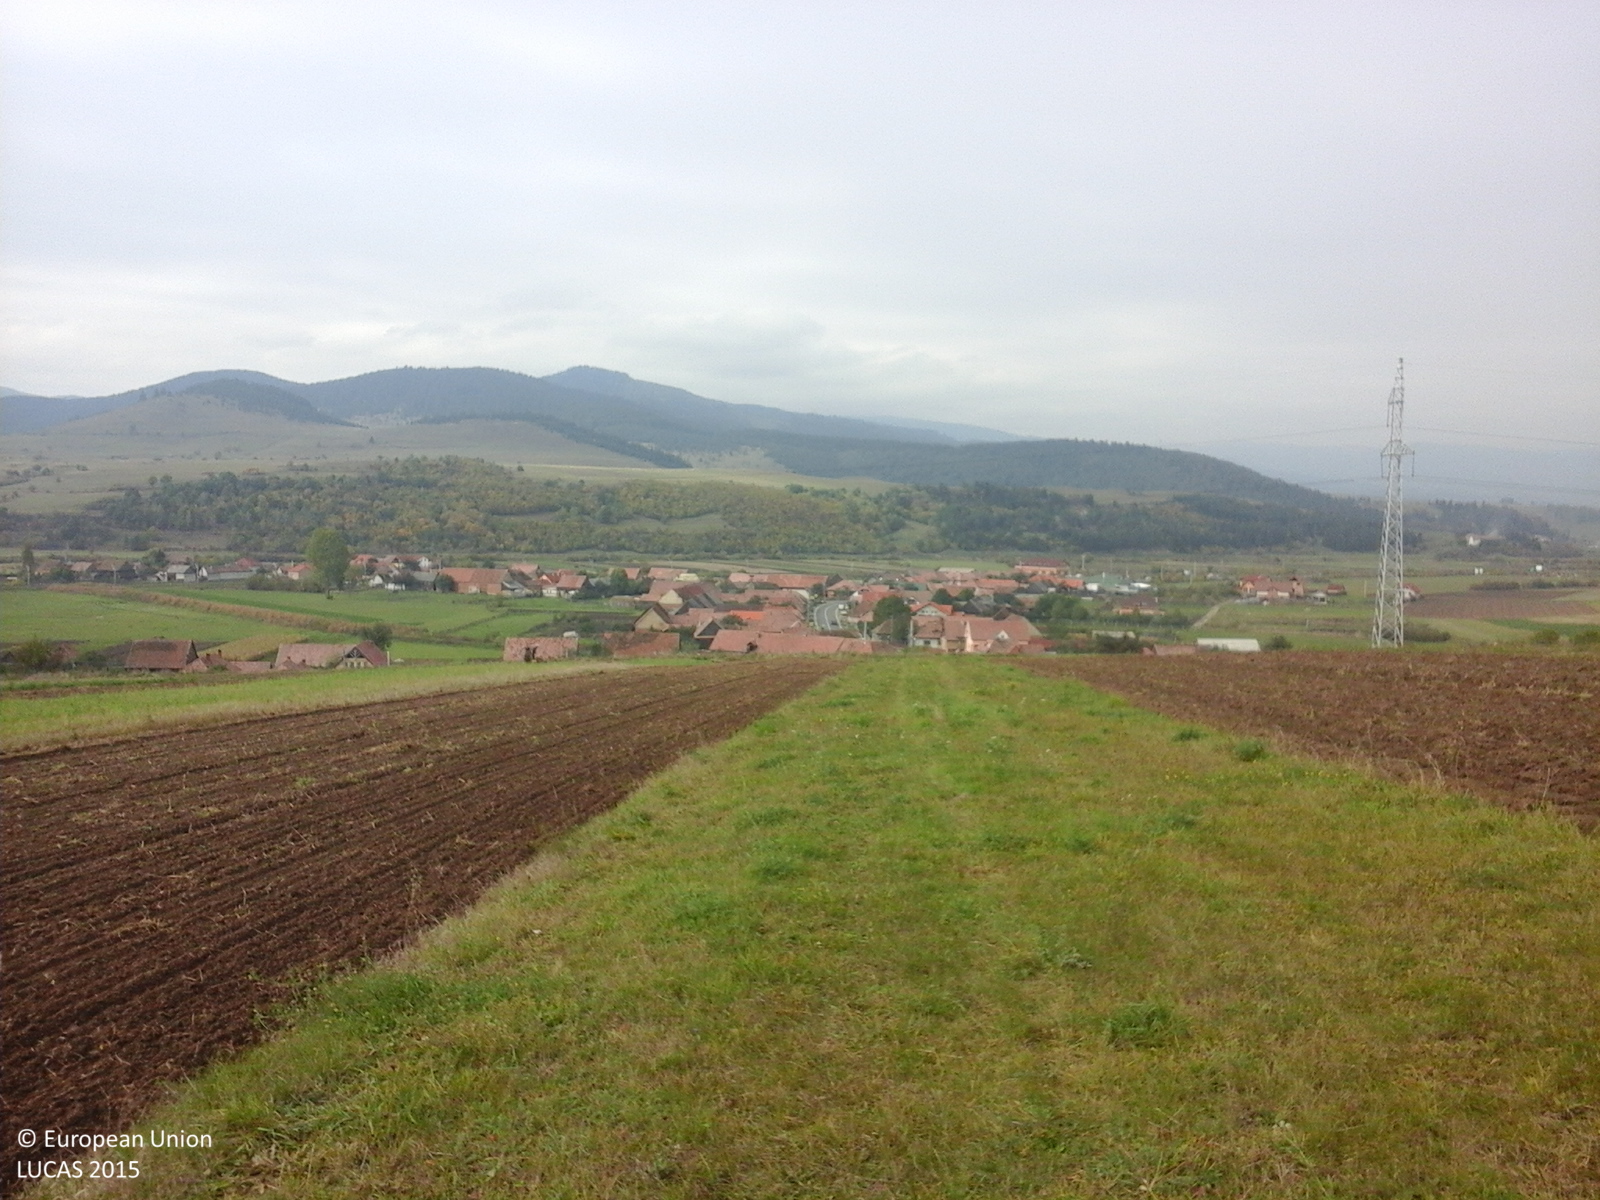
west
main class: Grassland
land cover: Grassland without tree/shrub cover
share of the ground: > 75 %
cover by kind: herbaceous plants 100 %
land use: Agriculture (excluding fallow land and kitchen gardens)
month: October
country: RO
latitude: 46.3165
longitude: 25.8425
